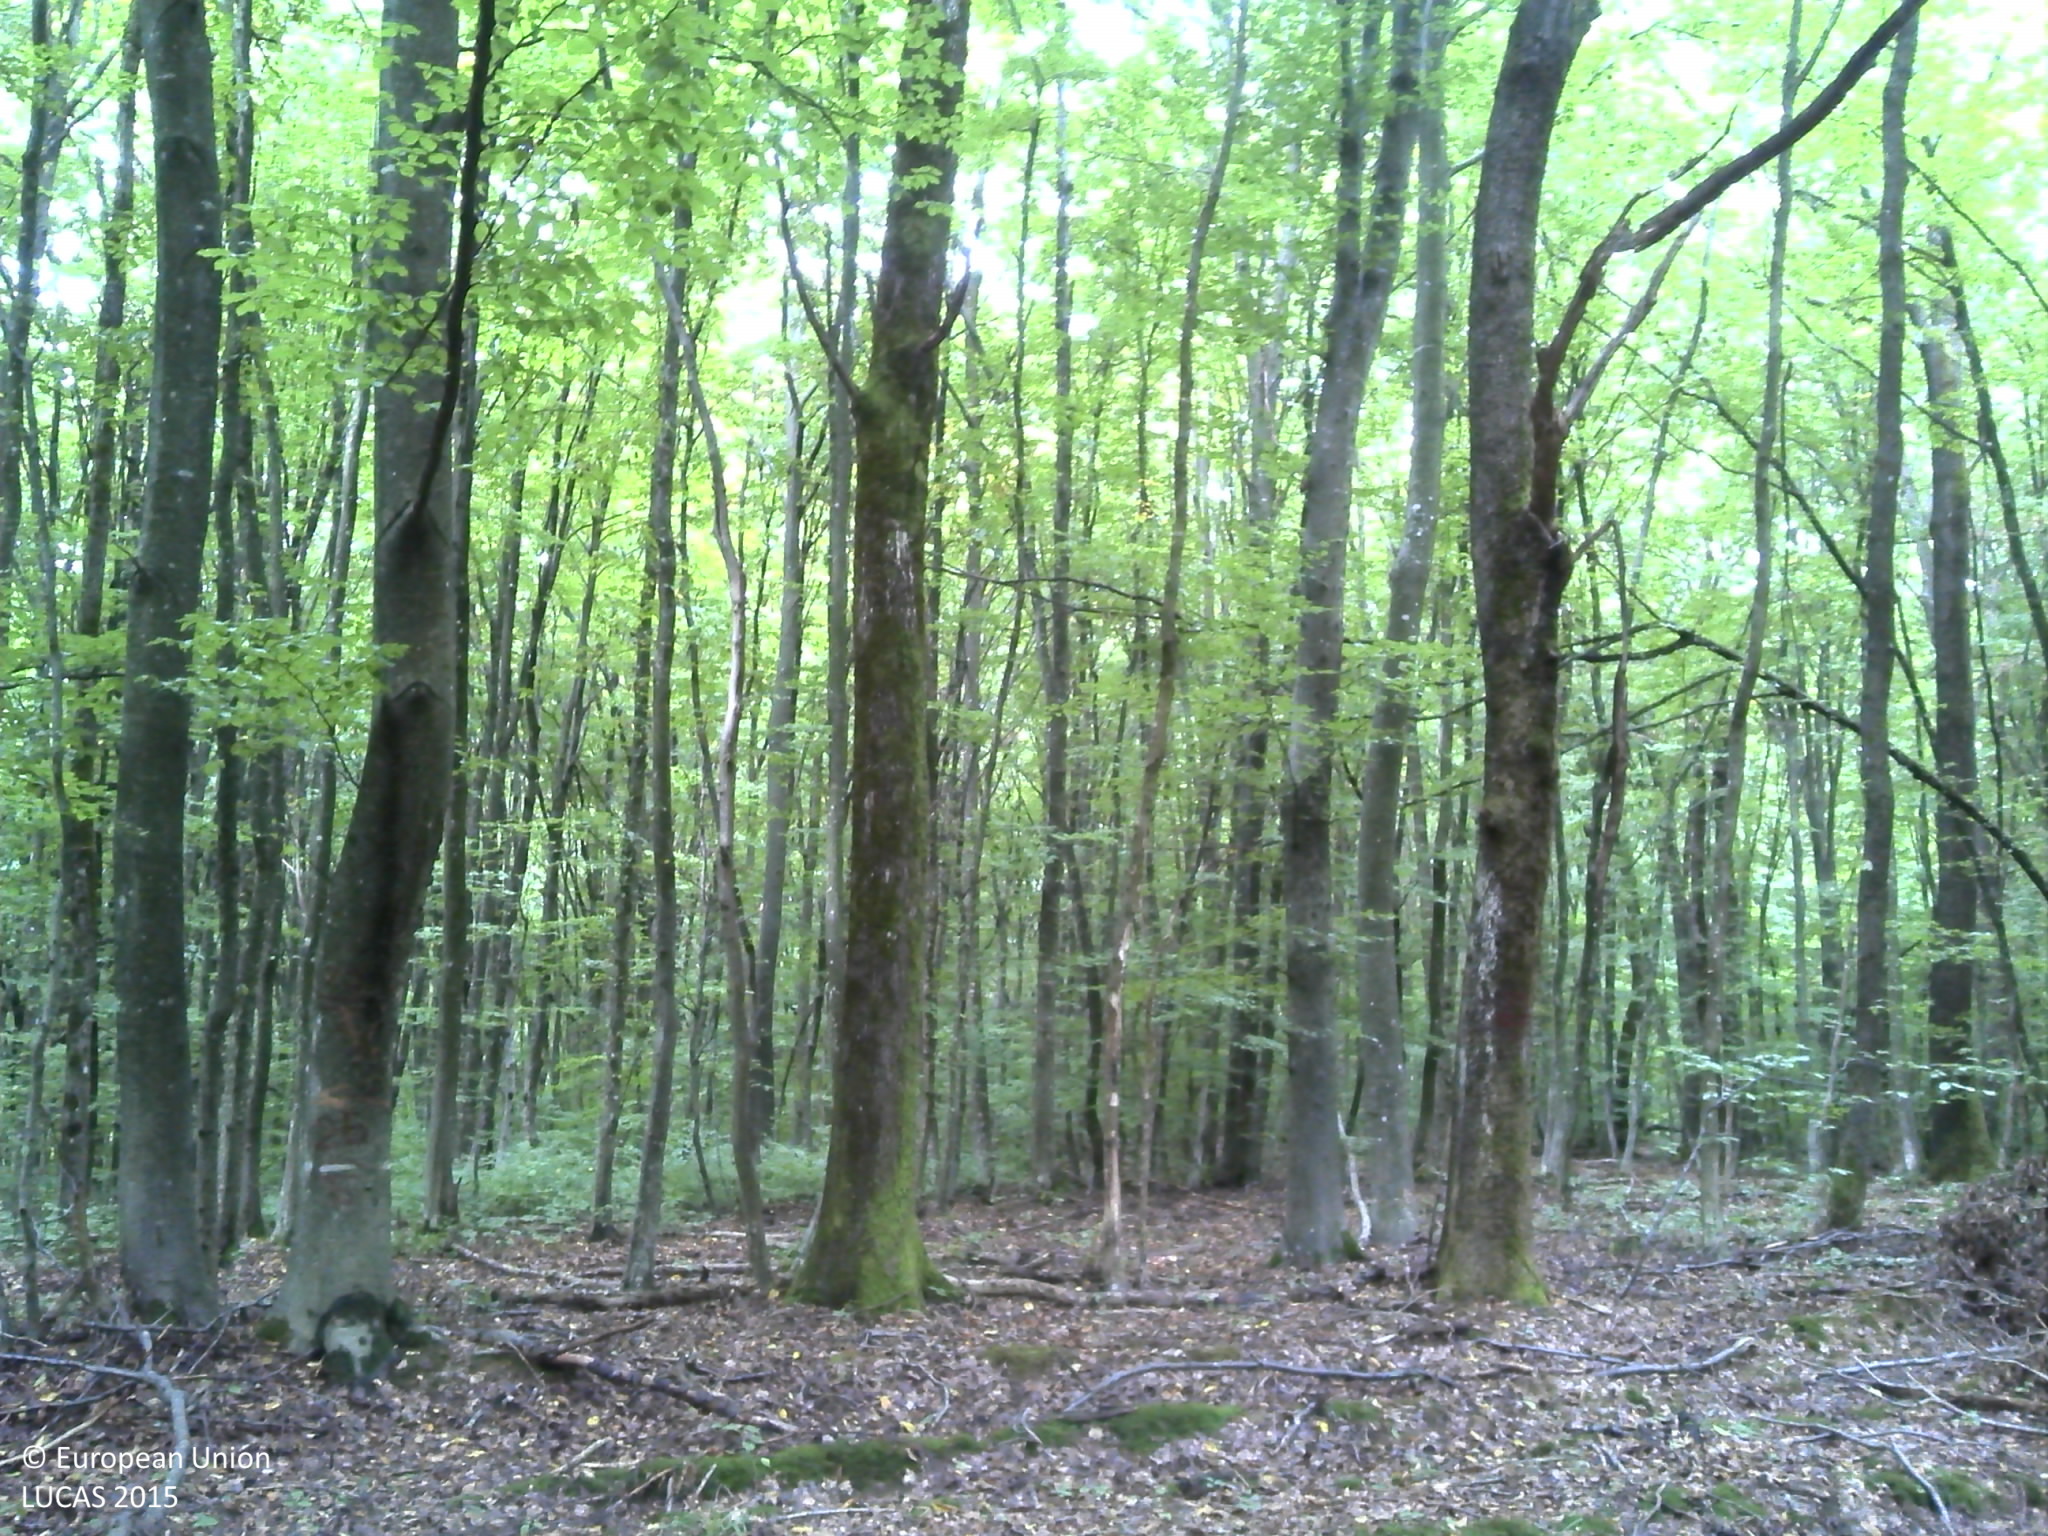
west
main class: Woodland
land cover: Broadleaved woodland
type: beech forest
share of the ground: > 75 %
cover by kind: broadleaved forest trees 100 %
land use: Forestry
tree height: > 5 m
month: August
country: HR
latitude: 45.4056
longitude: 15.6817
